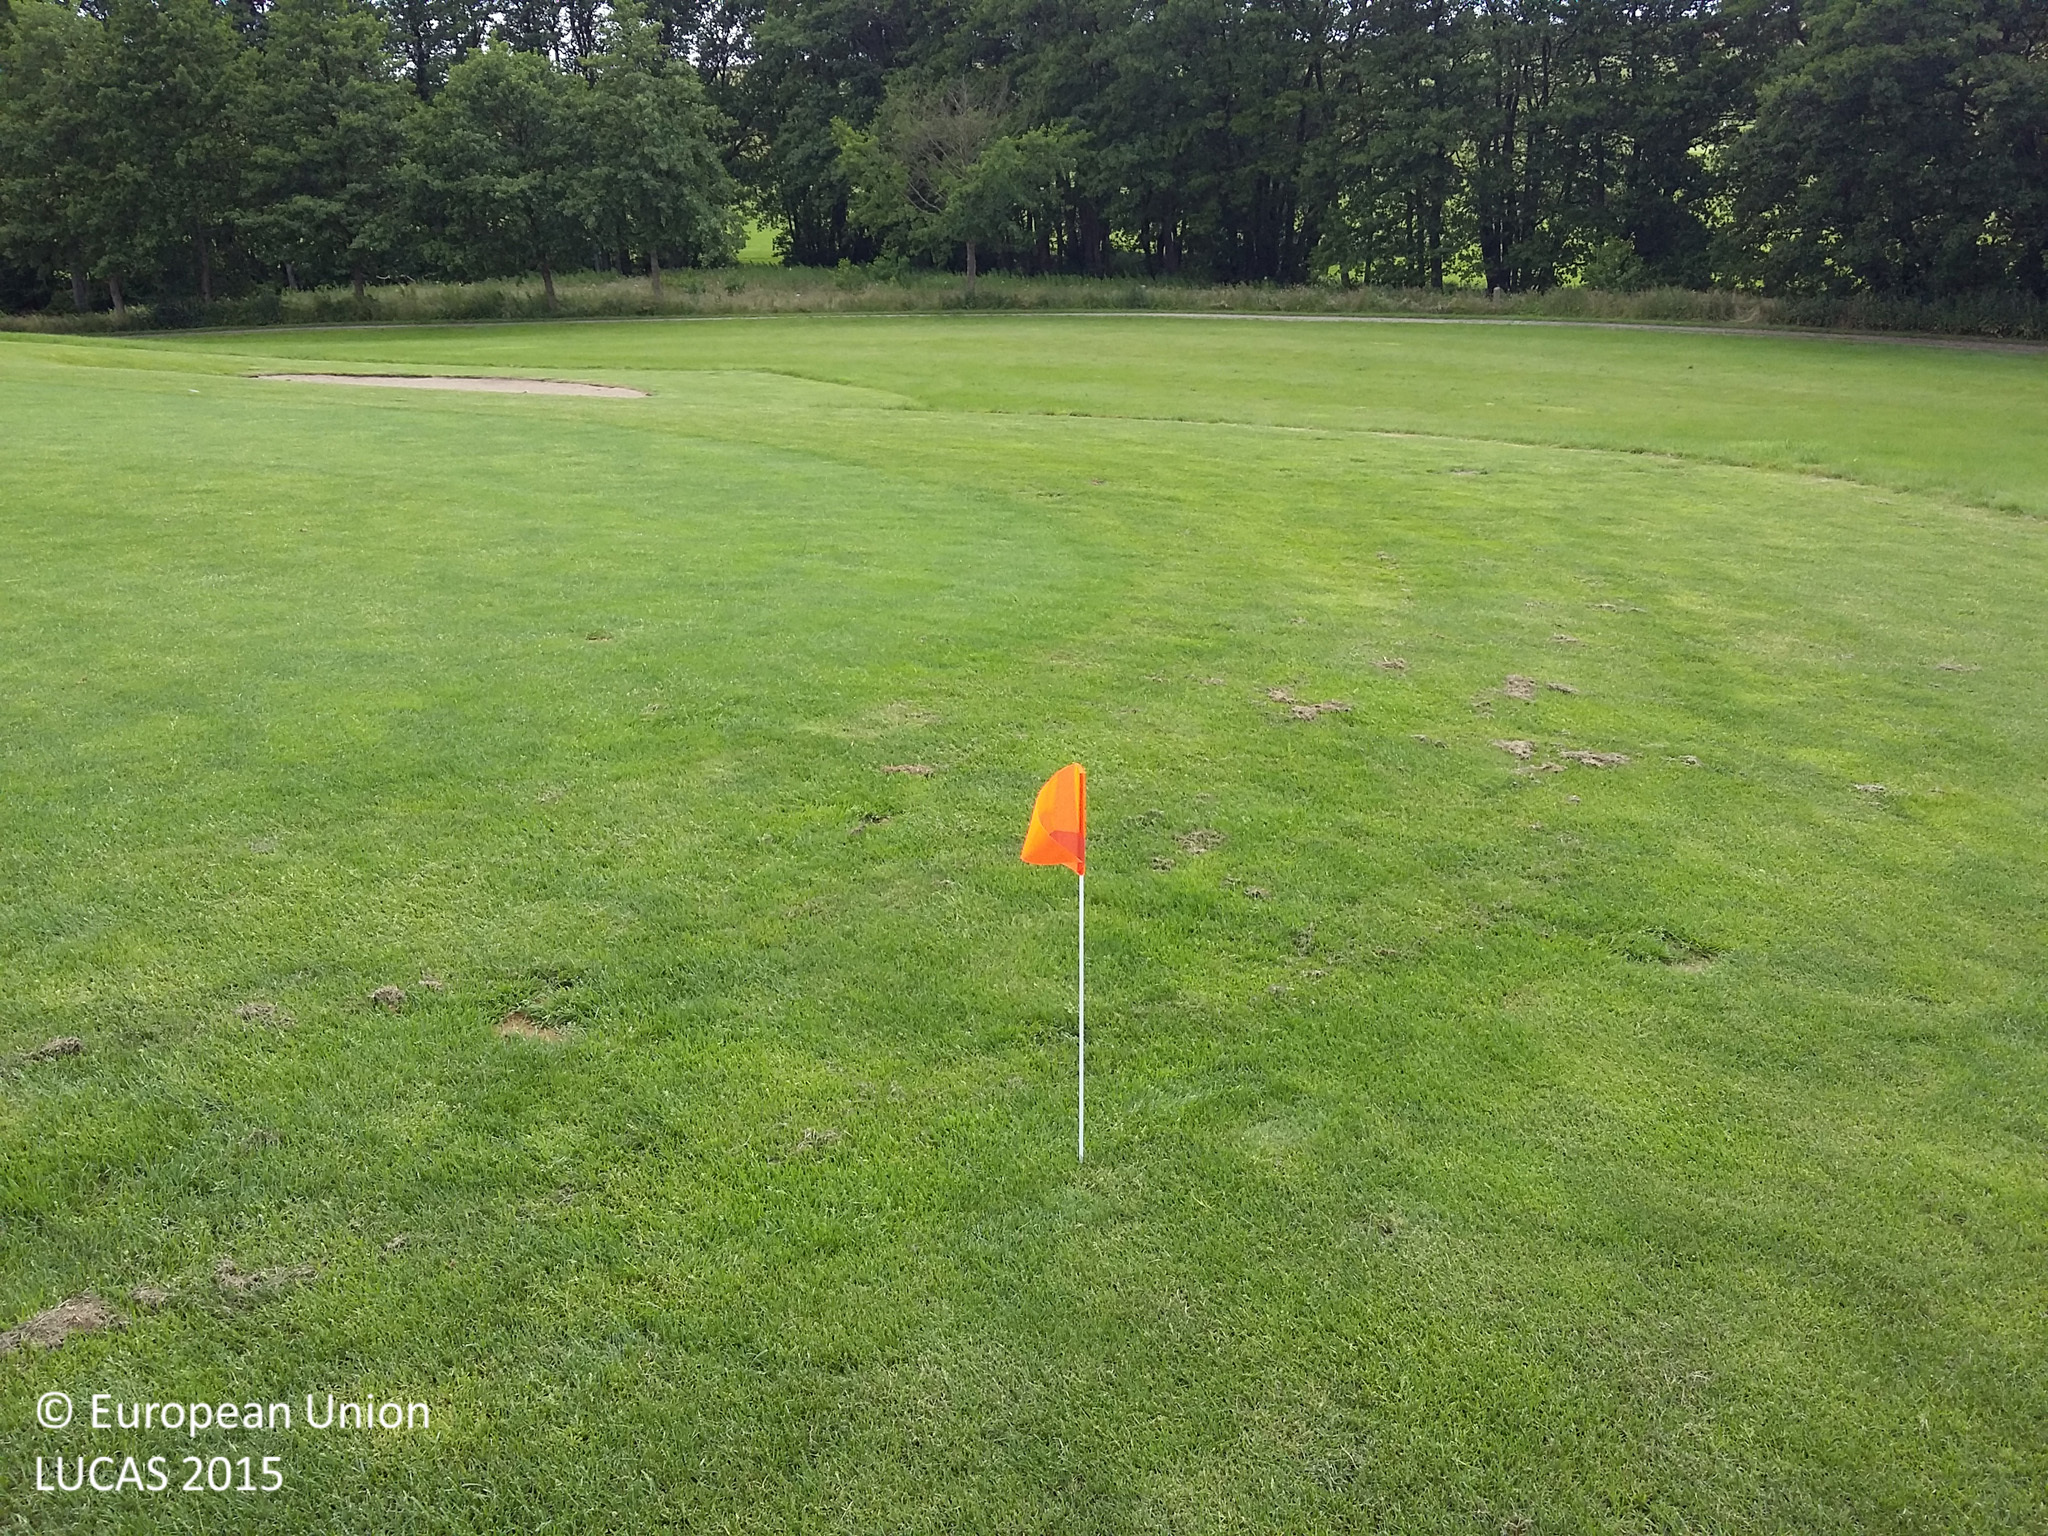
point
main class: Grassland
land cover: Grassland without tree/shrub cover
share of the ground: > 75 %
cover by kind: herbaceous plants 100 %
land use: Sport
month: July
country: DK
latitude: 55.3872
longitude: 11.5615
